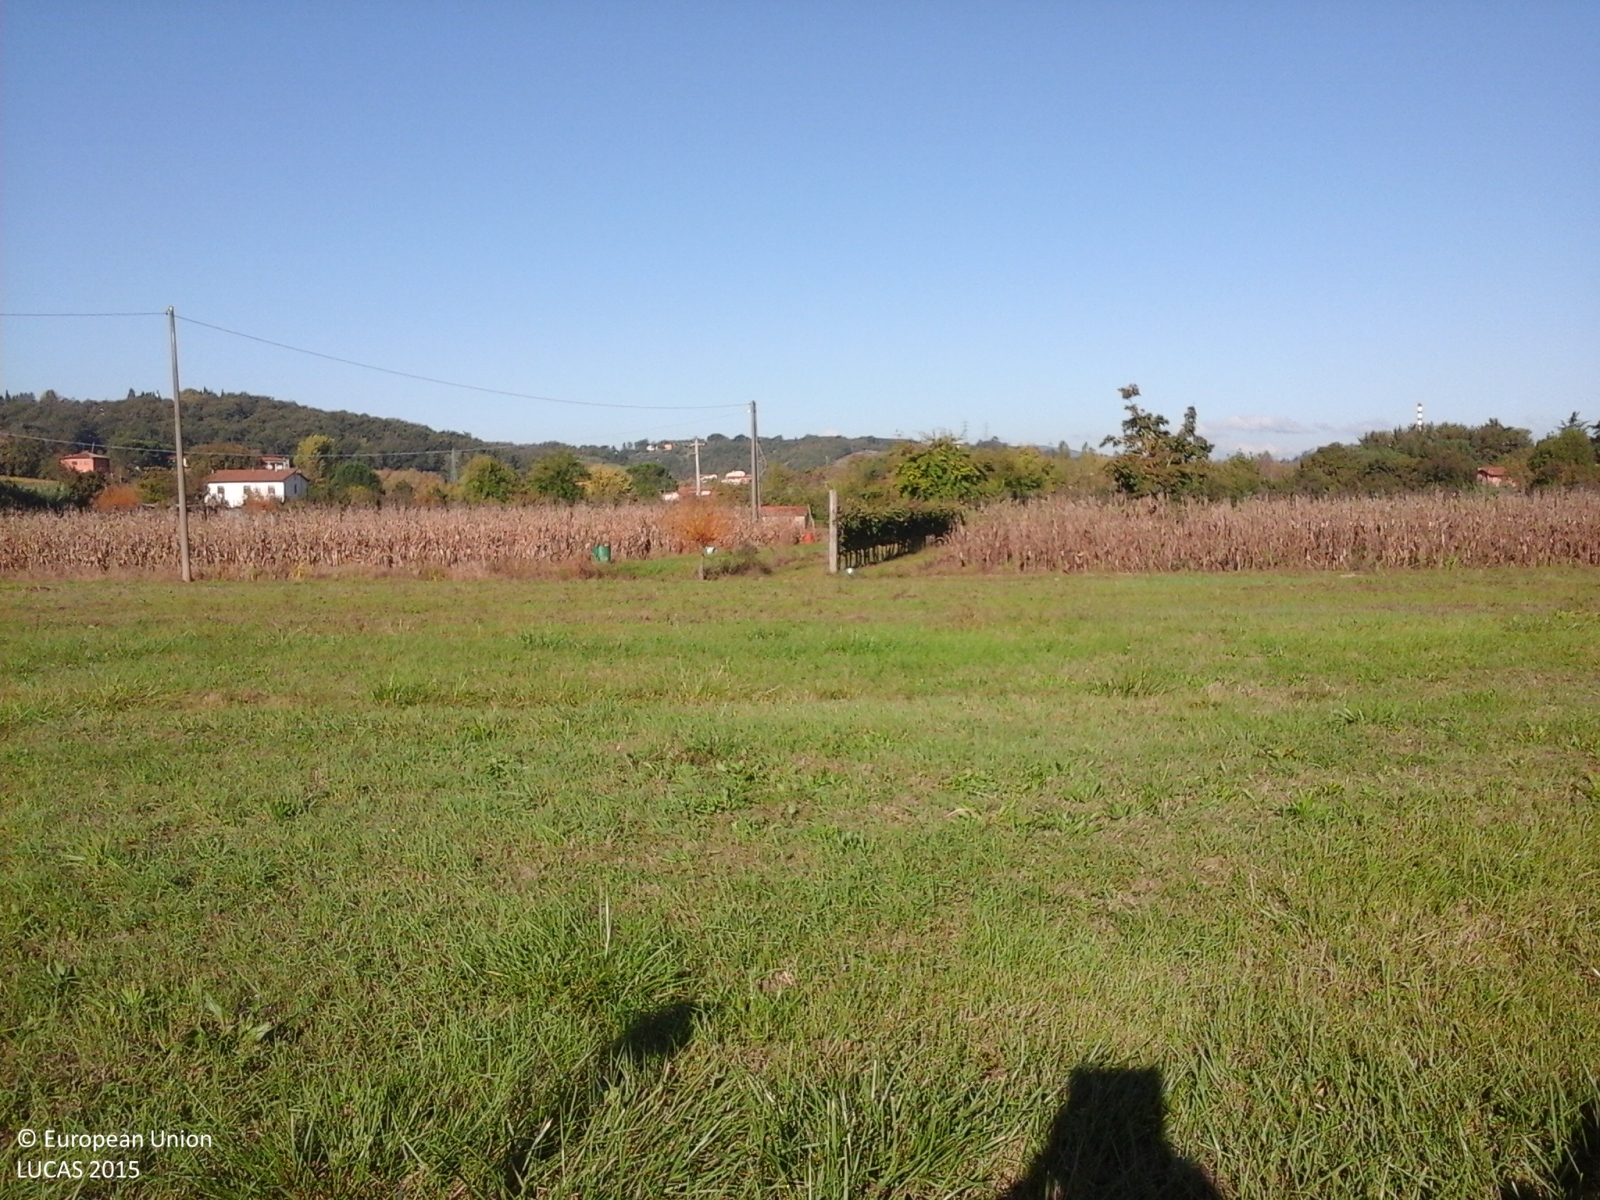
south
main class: Grassland
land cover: Grassland without tree/shrub cover
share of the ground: > 75 %
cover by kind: herbaceous plants 100 %
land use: Agriculture (excluding fallow land and kitchen gardens)
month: October
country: IT
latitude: 43.5451
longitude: 11.5429
